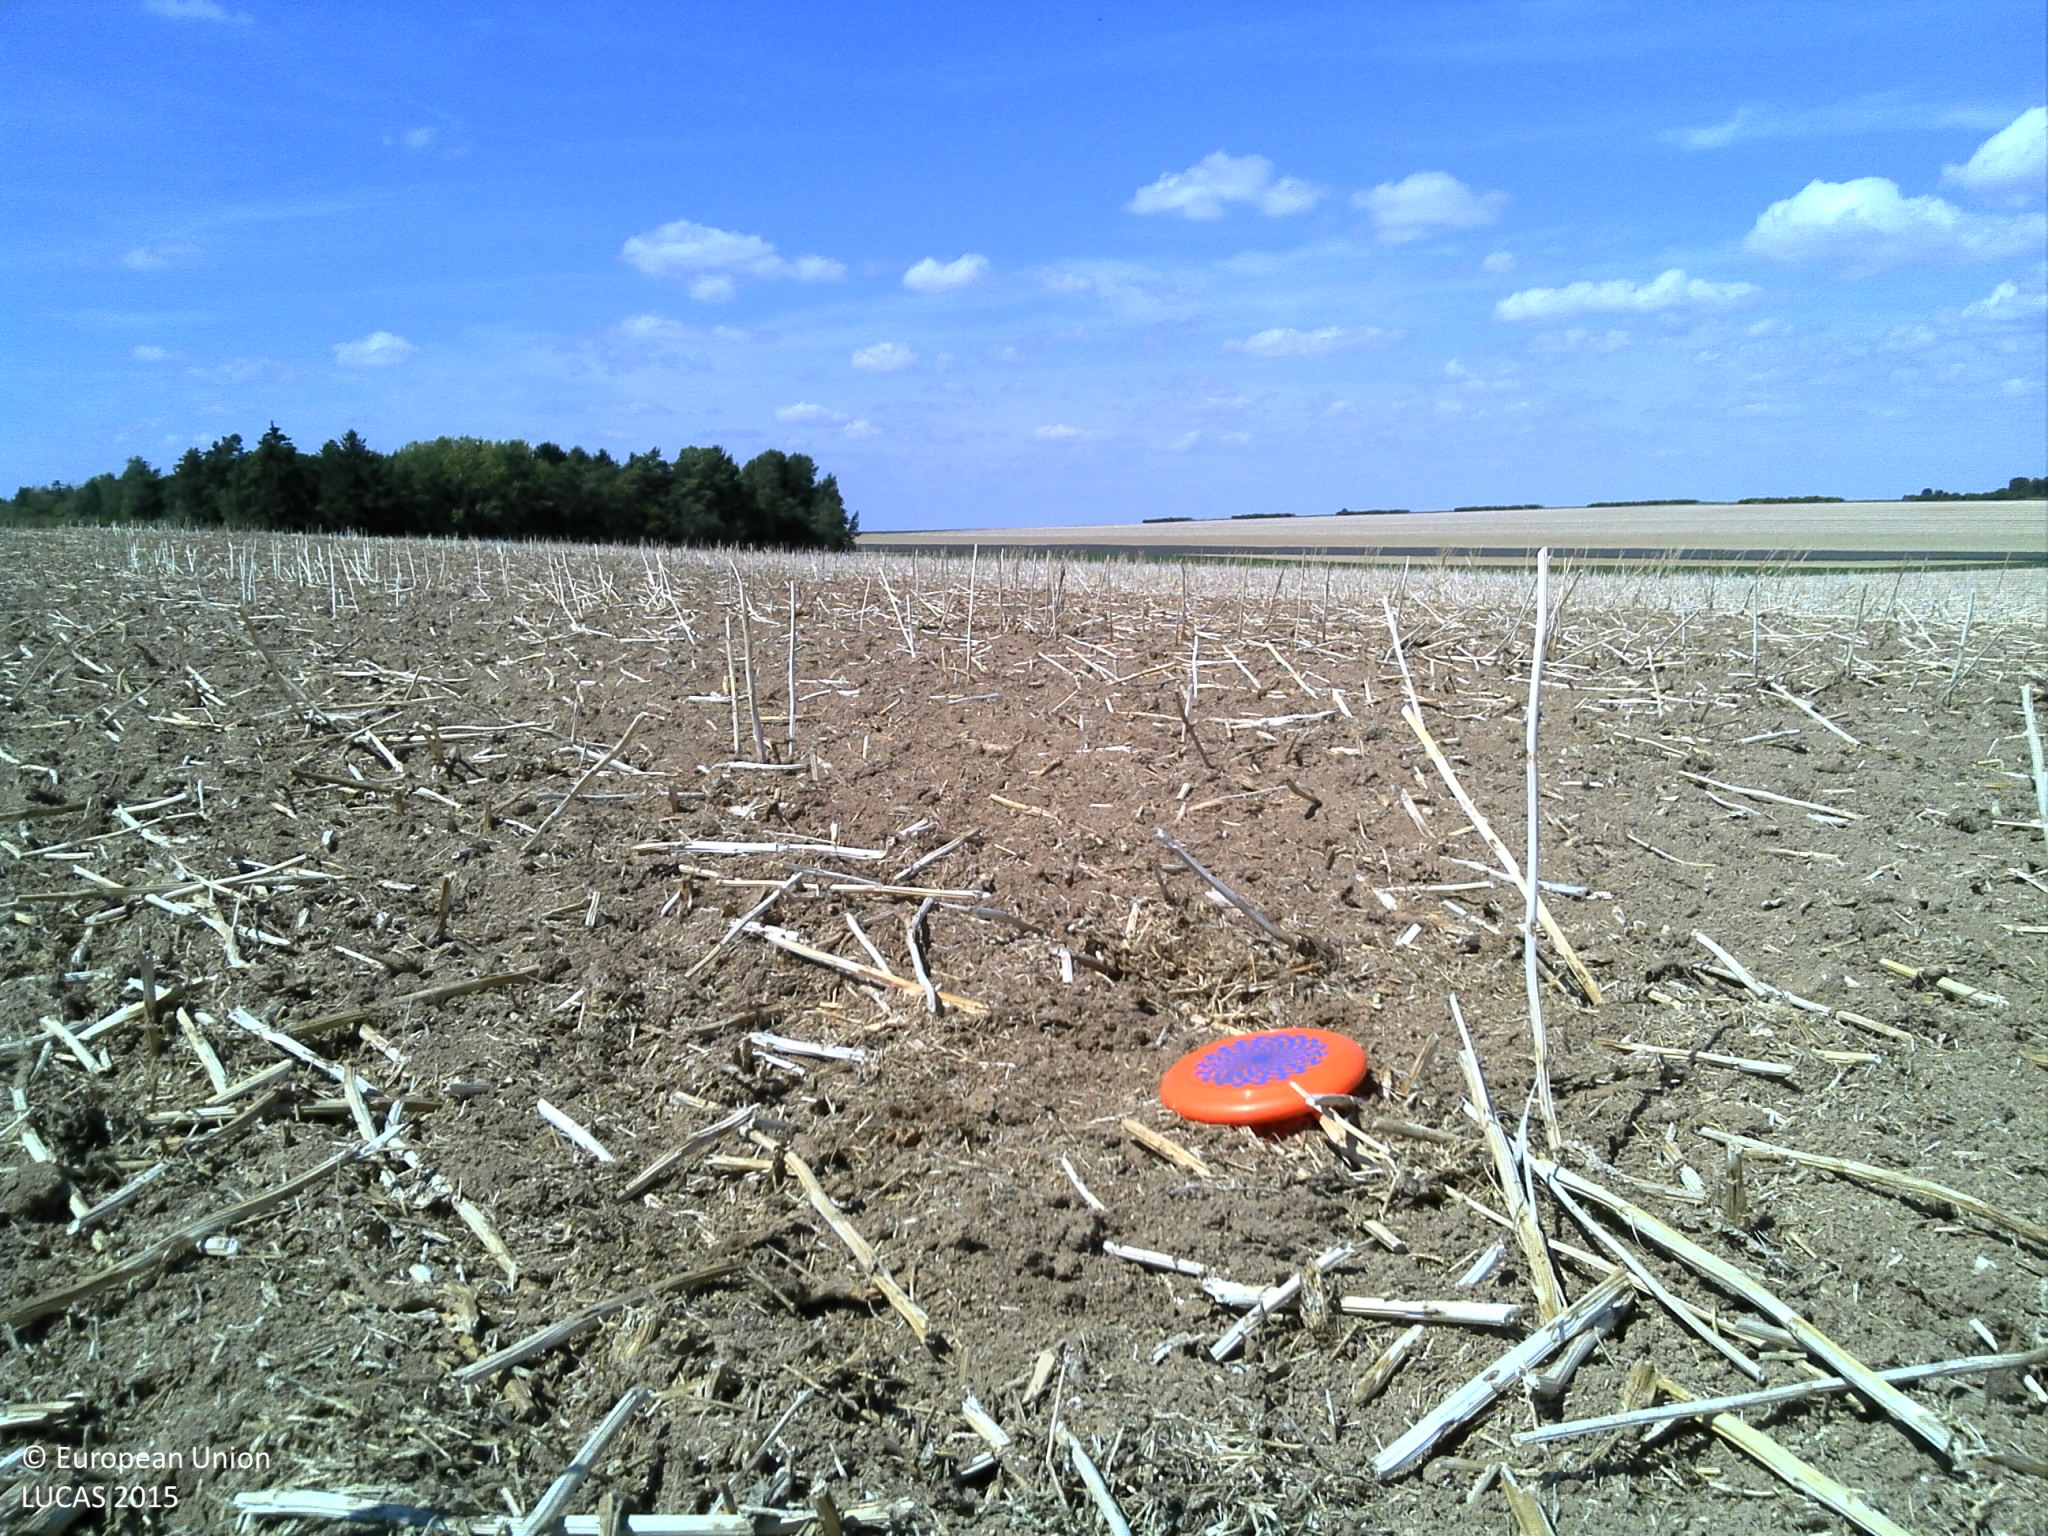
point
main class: Cropland
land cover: Rape and turnip rape
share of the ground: > 75 %
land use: Agriculture (excluding fallow land and kitchen gardens)
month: August
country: FR
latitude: 49.0133
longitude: 4.6511
